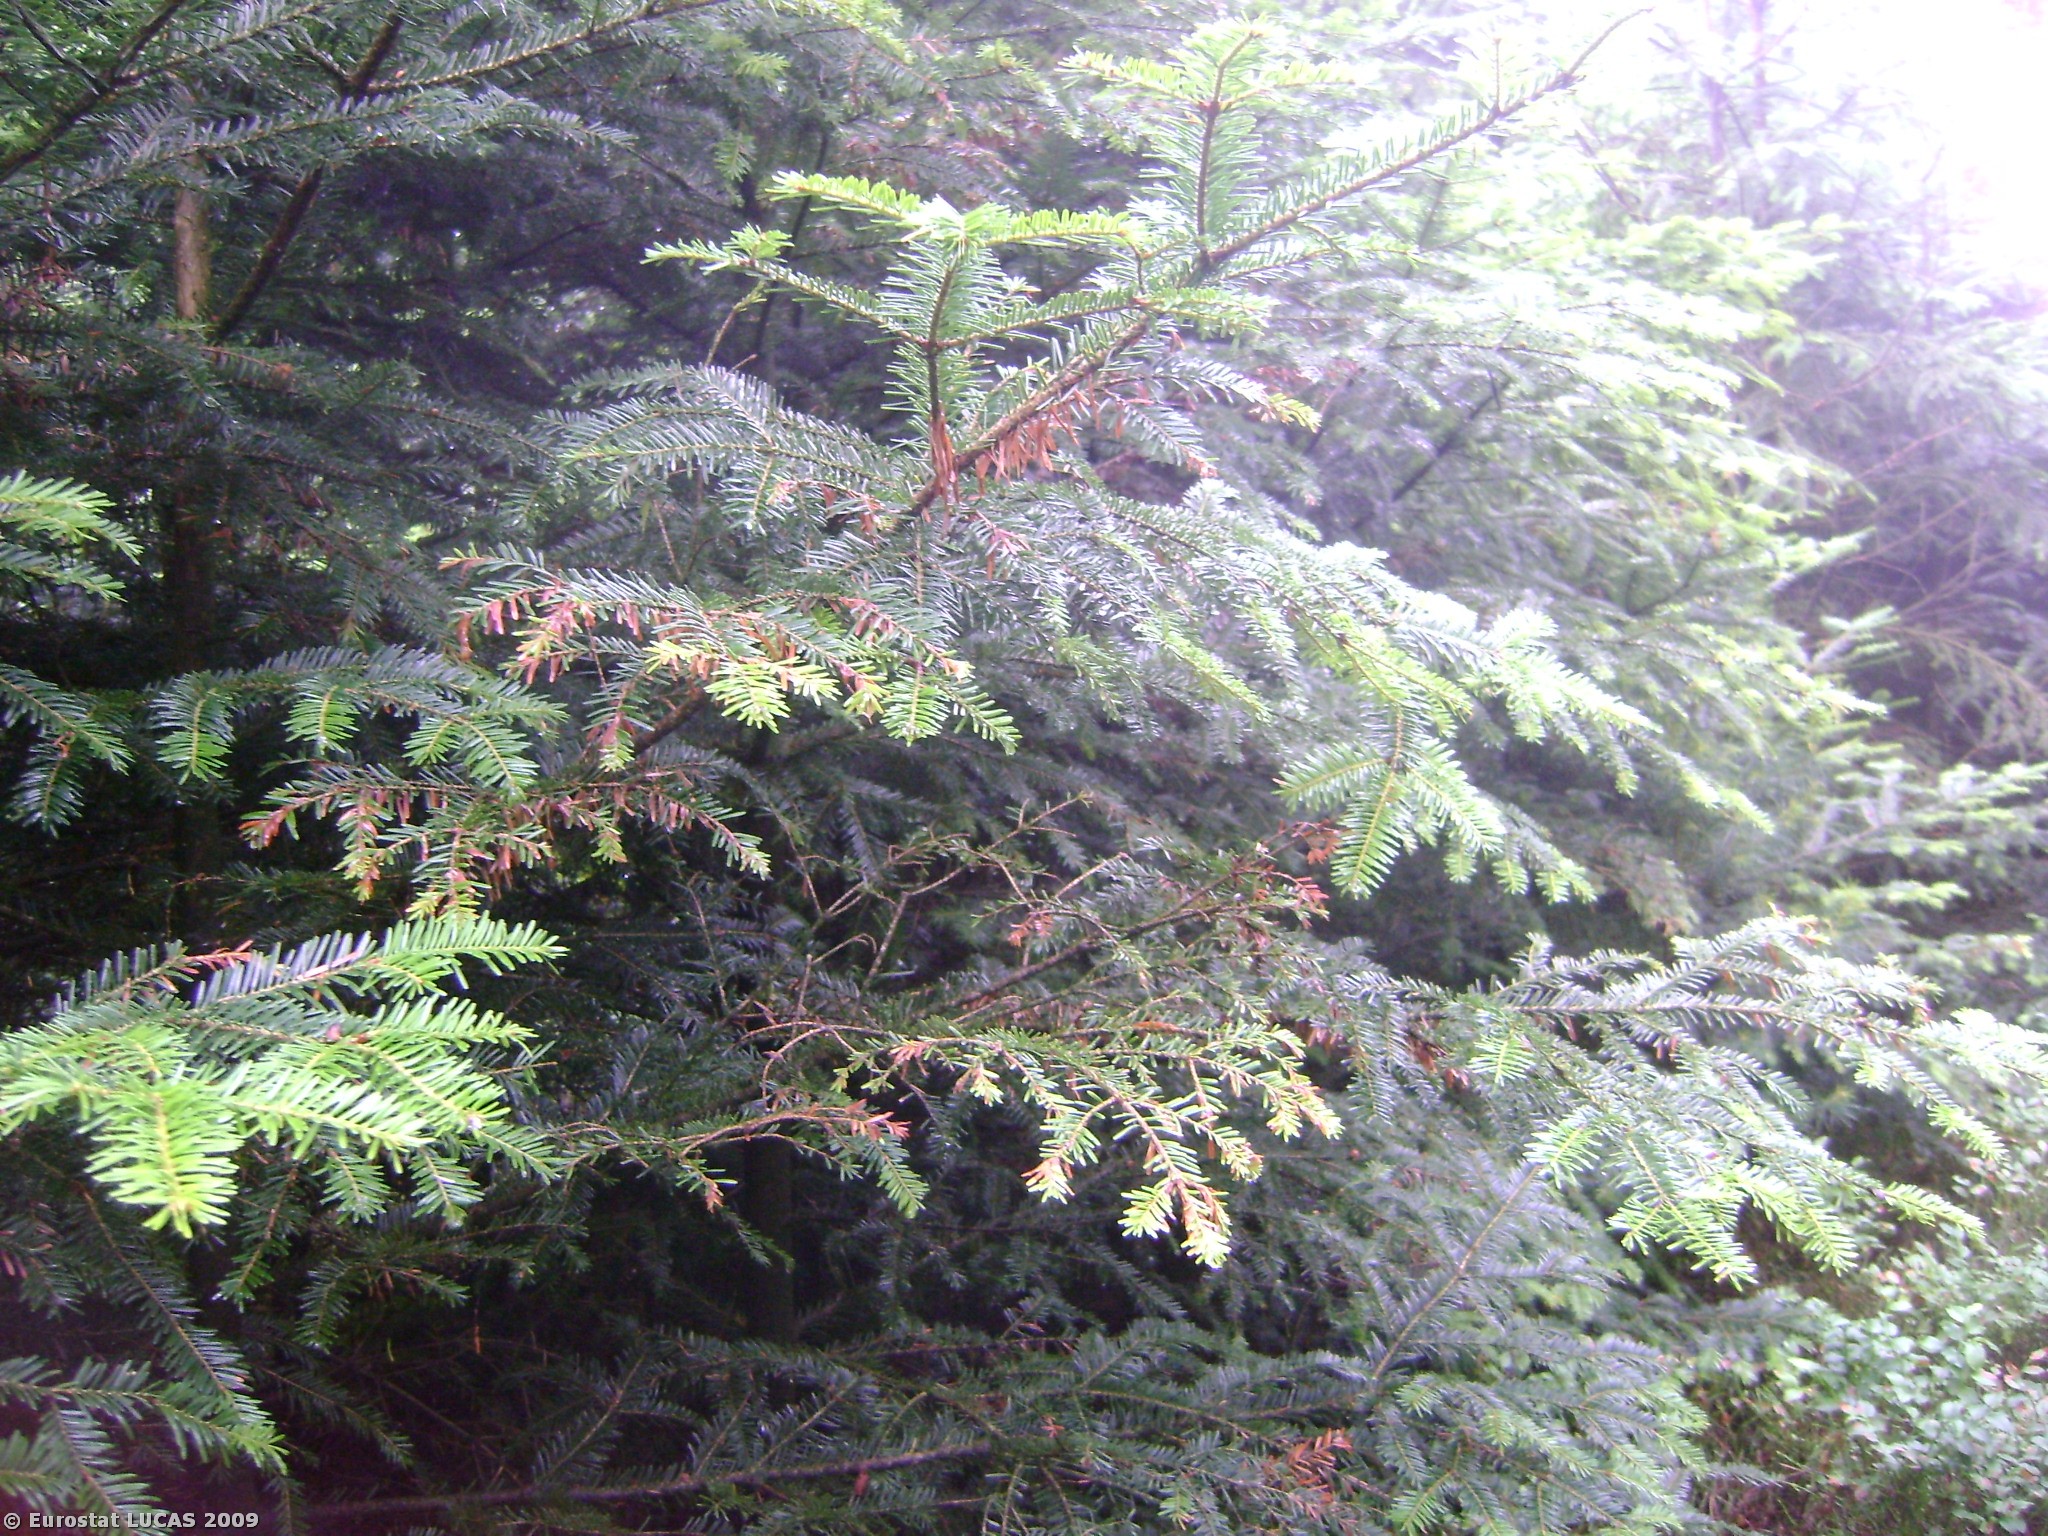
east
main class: Woodland
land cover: Coniferous woodland
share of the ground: > 75 %
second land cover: Shrubland with sparse tree cover
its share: 10 - 25 %
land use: Forestry
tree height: < 5 m
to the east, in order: Coniferous woodland; Shrubland with sparse tree cover; Coniferous woodland; Tracks; Shrubland with sparse tree cover; Mixed woodland; Broadleaved woodland; Shrubland with sparse tree cover; Broadleaved woodland; Shrubland with sparse tree cover
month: June
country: AT
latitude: 48.1041
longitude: 13.2355
